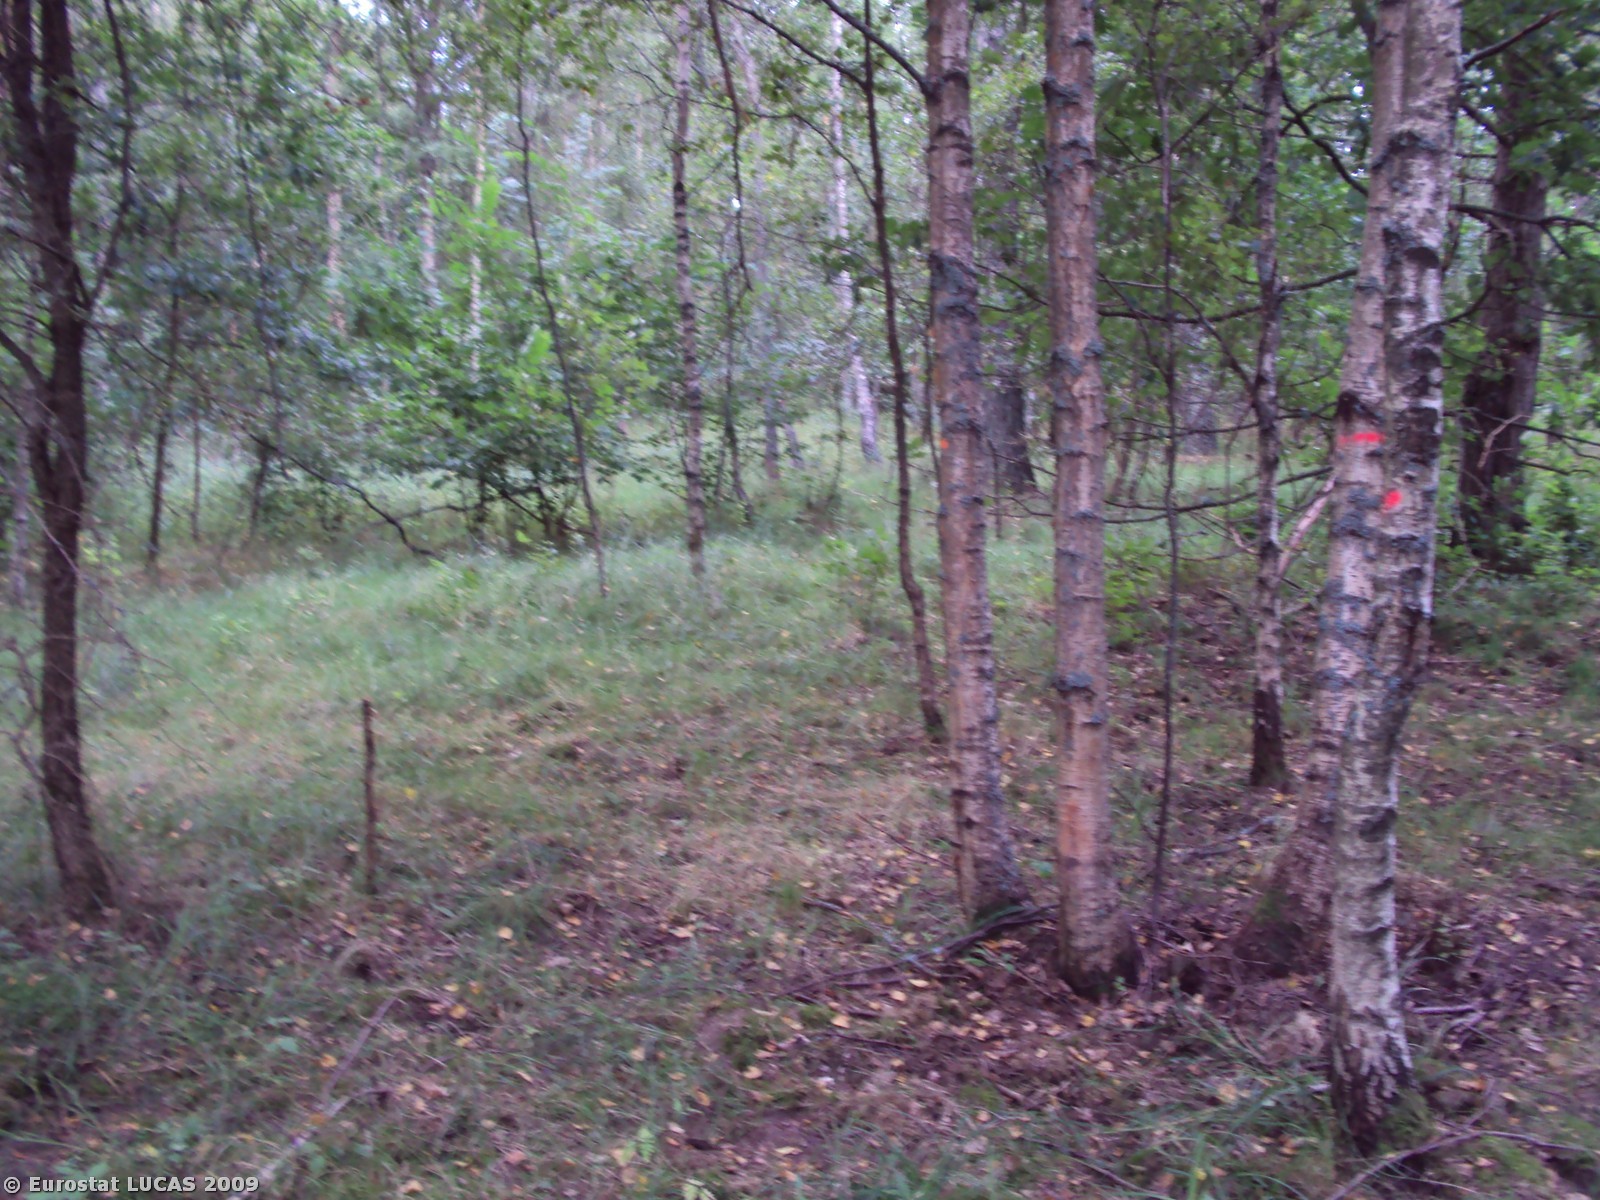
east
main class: Woodland
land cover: Mixed woodland
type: hemiboreal forest and nemoral coniferous forest and mixed broadleaved-coniferous forest
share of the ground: > 75 %
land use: Forestry
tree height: > 5 m
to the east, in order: Mixed woodland; Tracks; Mixed woodland
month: August
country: PL
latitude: 53.4928
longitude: 16.5941
